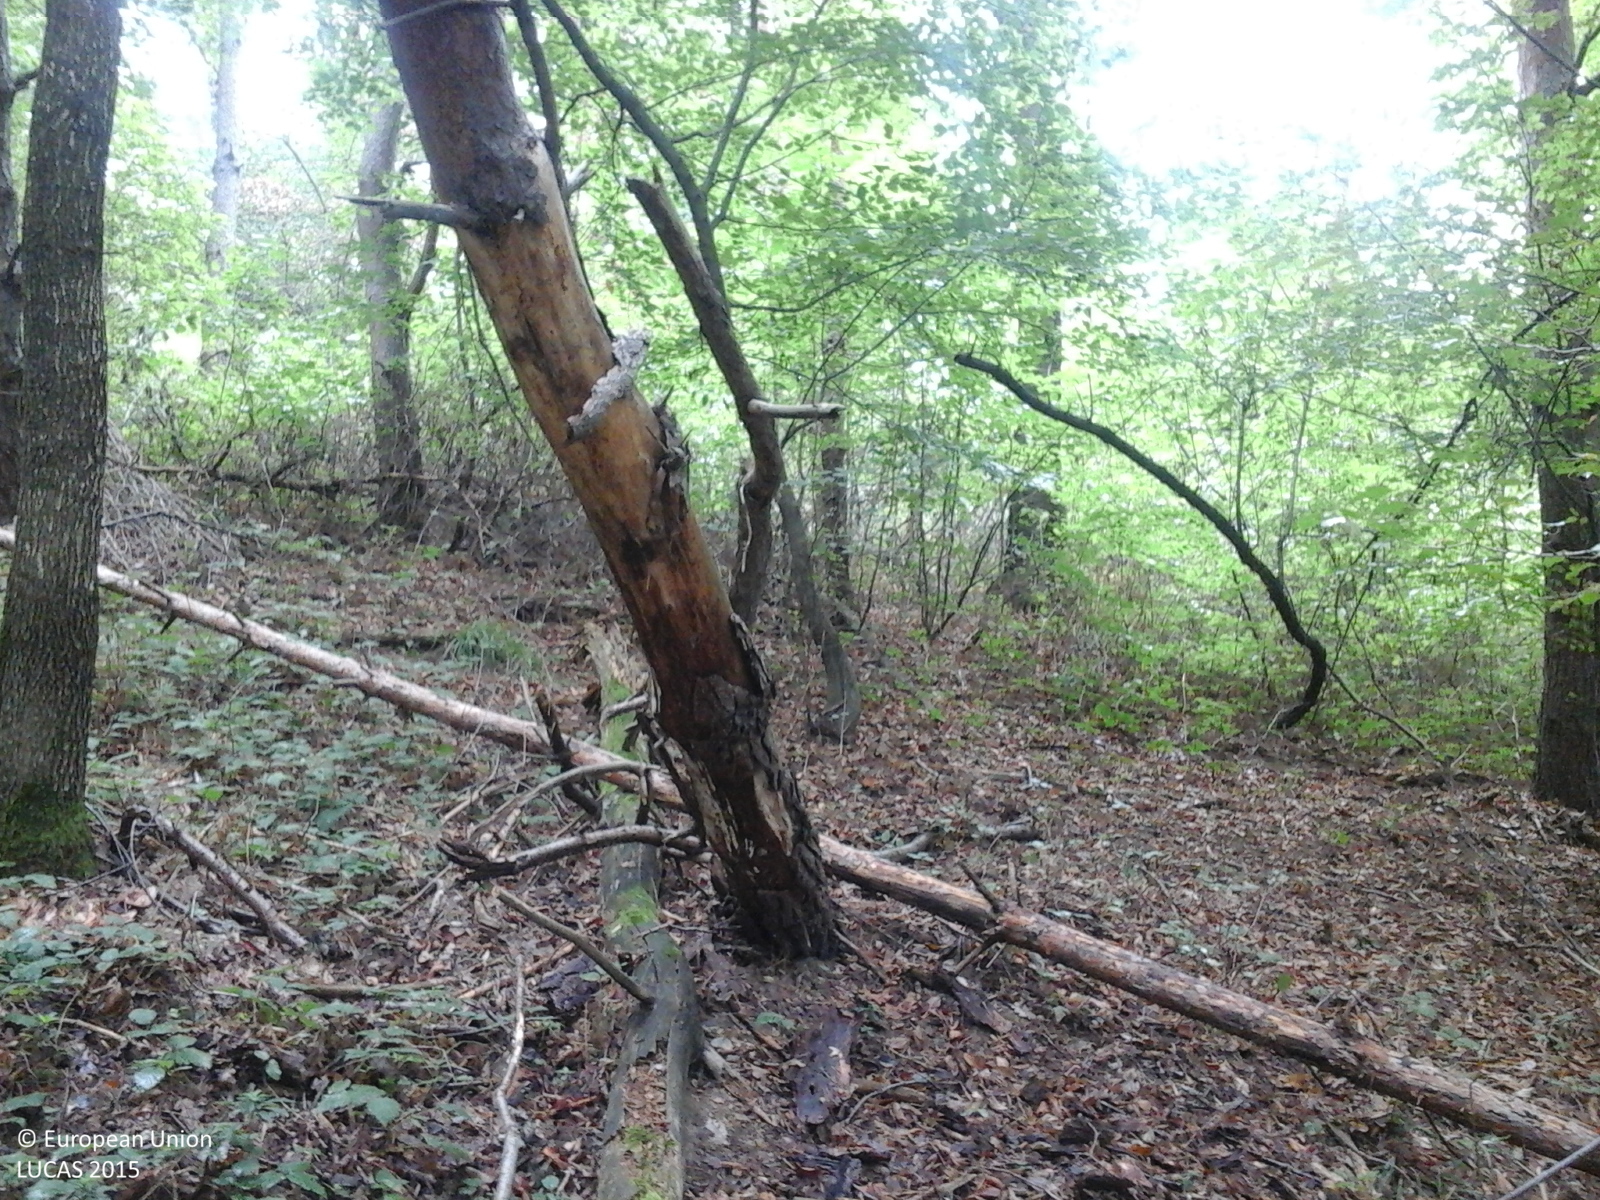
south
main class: Woodland
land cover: Broadleaved woodland
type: mesophytic deciduous forest
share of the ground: > 75 %
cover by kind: broadleaved forest trees 100 %
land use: Forestry
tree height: > 5 m
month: September
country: RO
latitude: 47.1815
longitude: 22.3381
